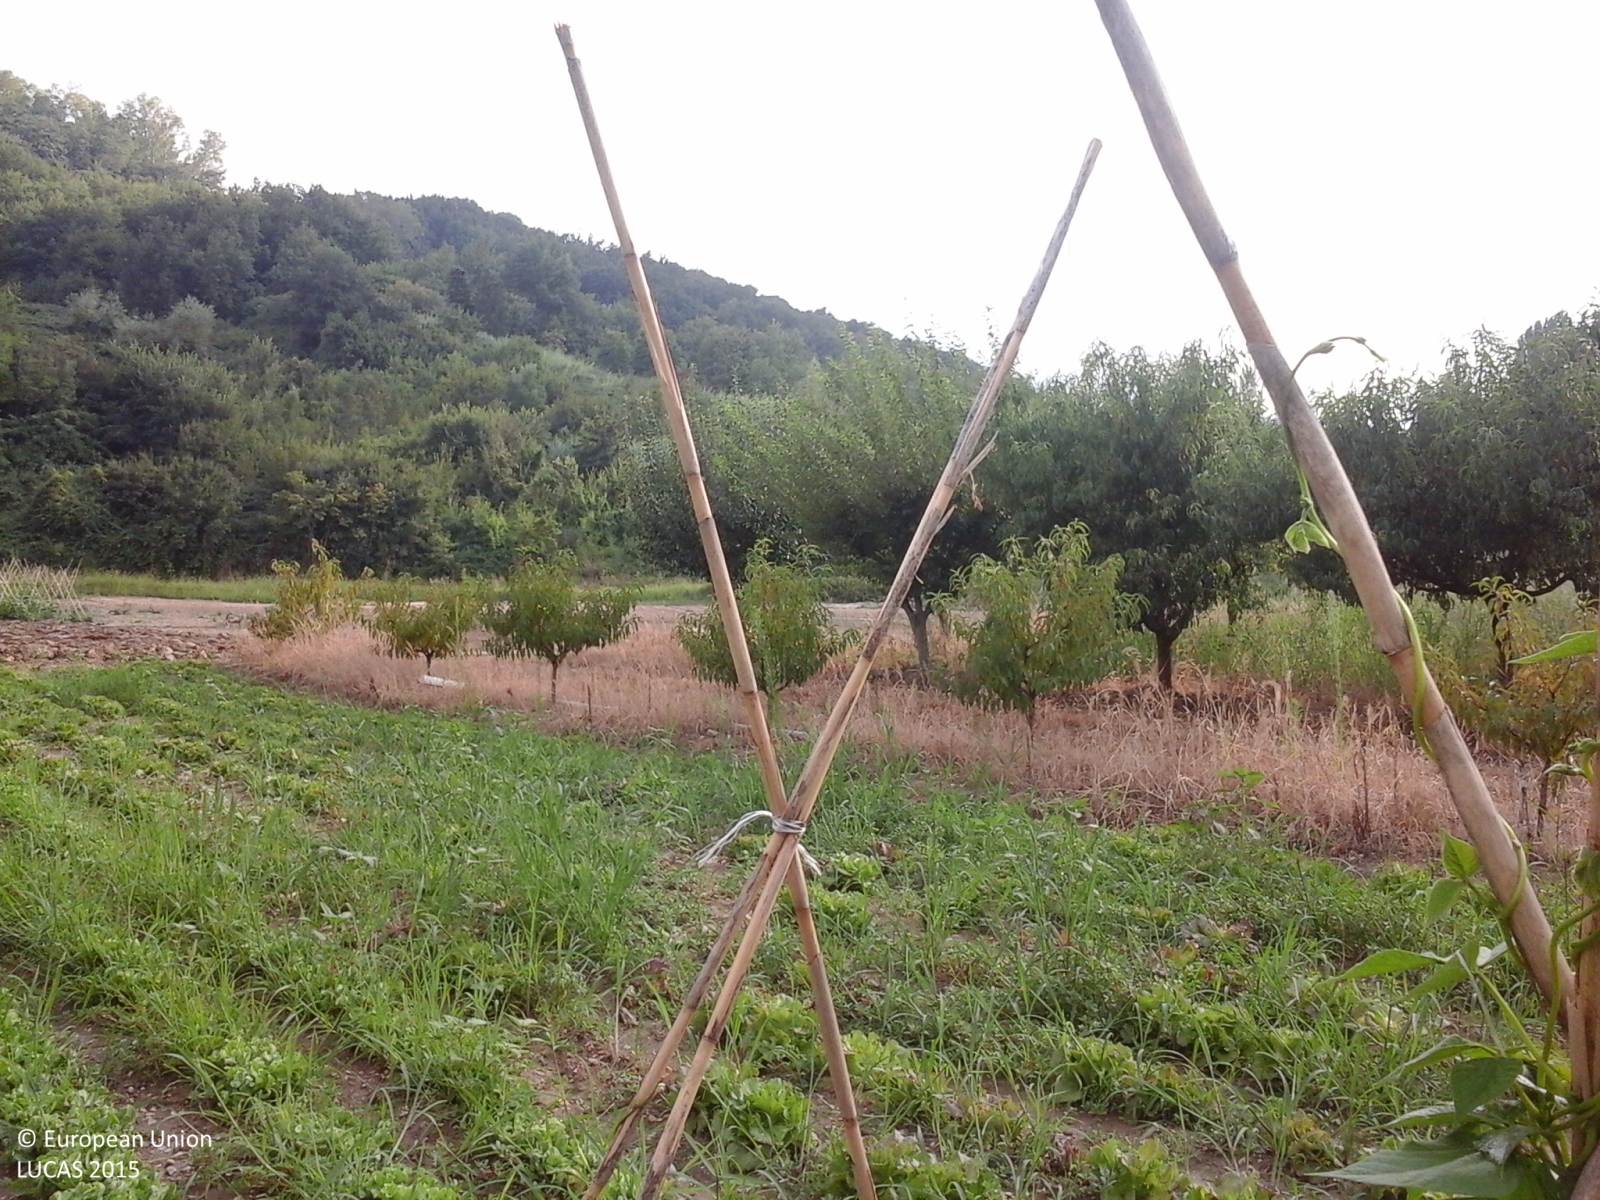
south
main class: Cropland
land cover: Dry pulses
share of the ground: > 75 %
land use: Agriculture (excluding fallow land and kitchen gardens)
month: August
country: IT
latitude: 43.3988
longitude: 13.1897
